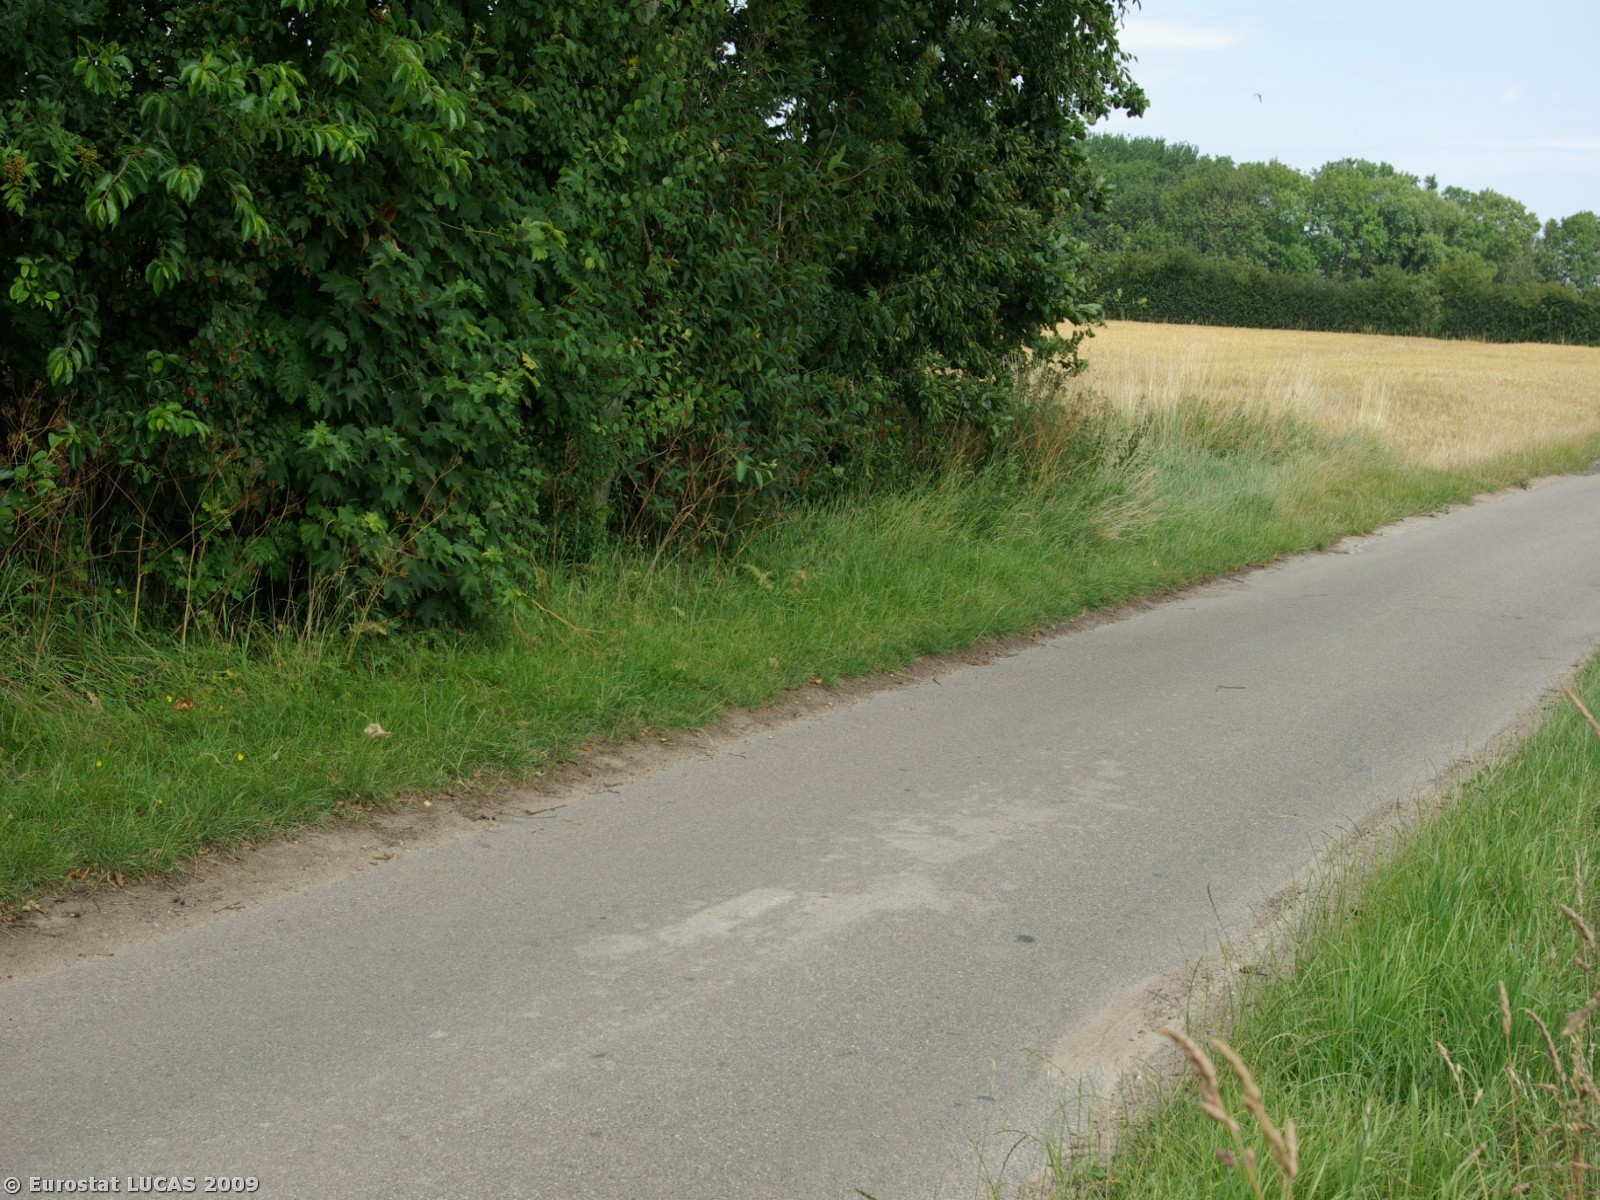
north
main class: Cropland
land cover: Barley
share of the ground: > 75 %
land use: Agriculture (excluding fallow land and kitchen gardens)
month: July
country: DK
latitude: 54.8936
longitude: 10.0467
